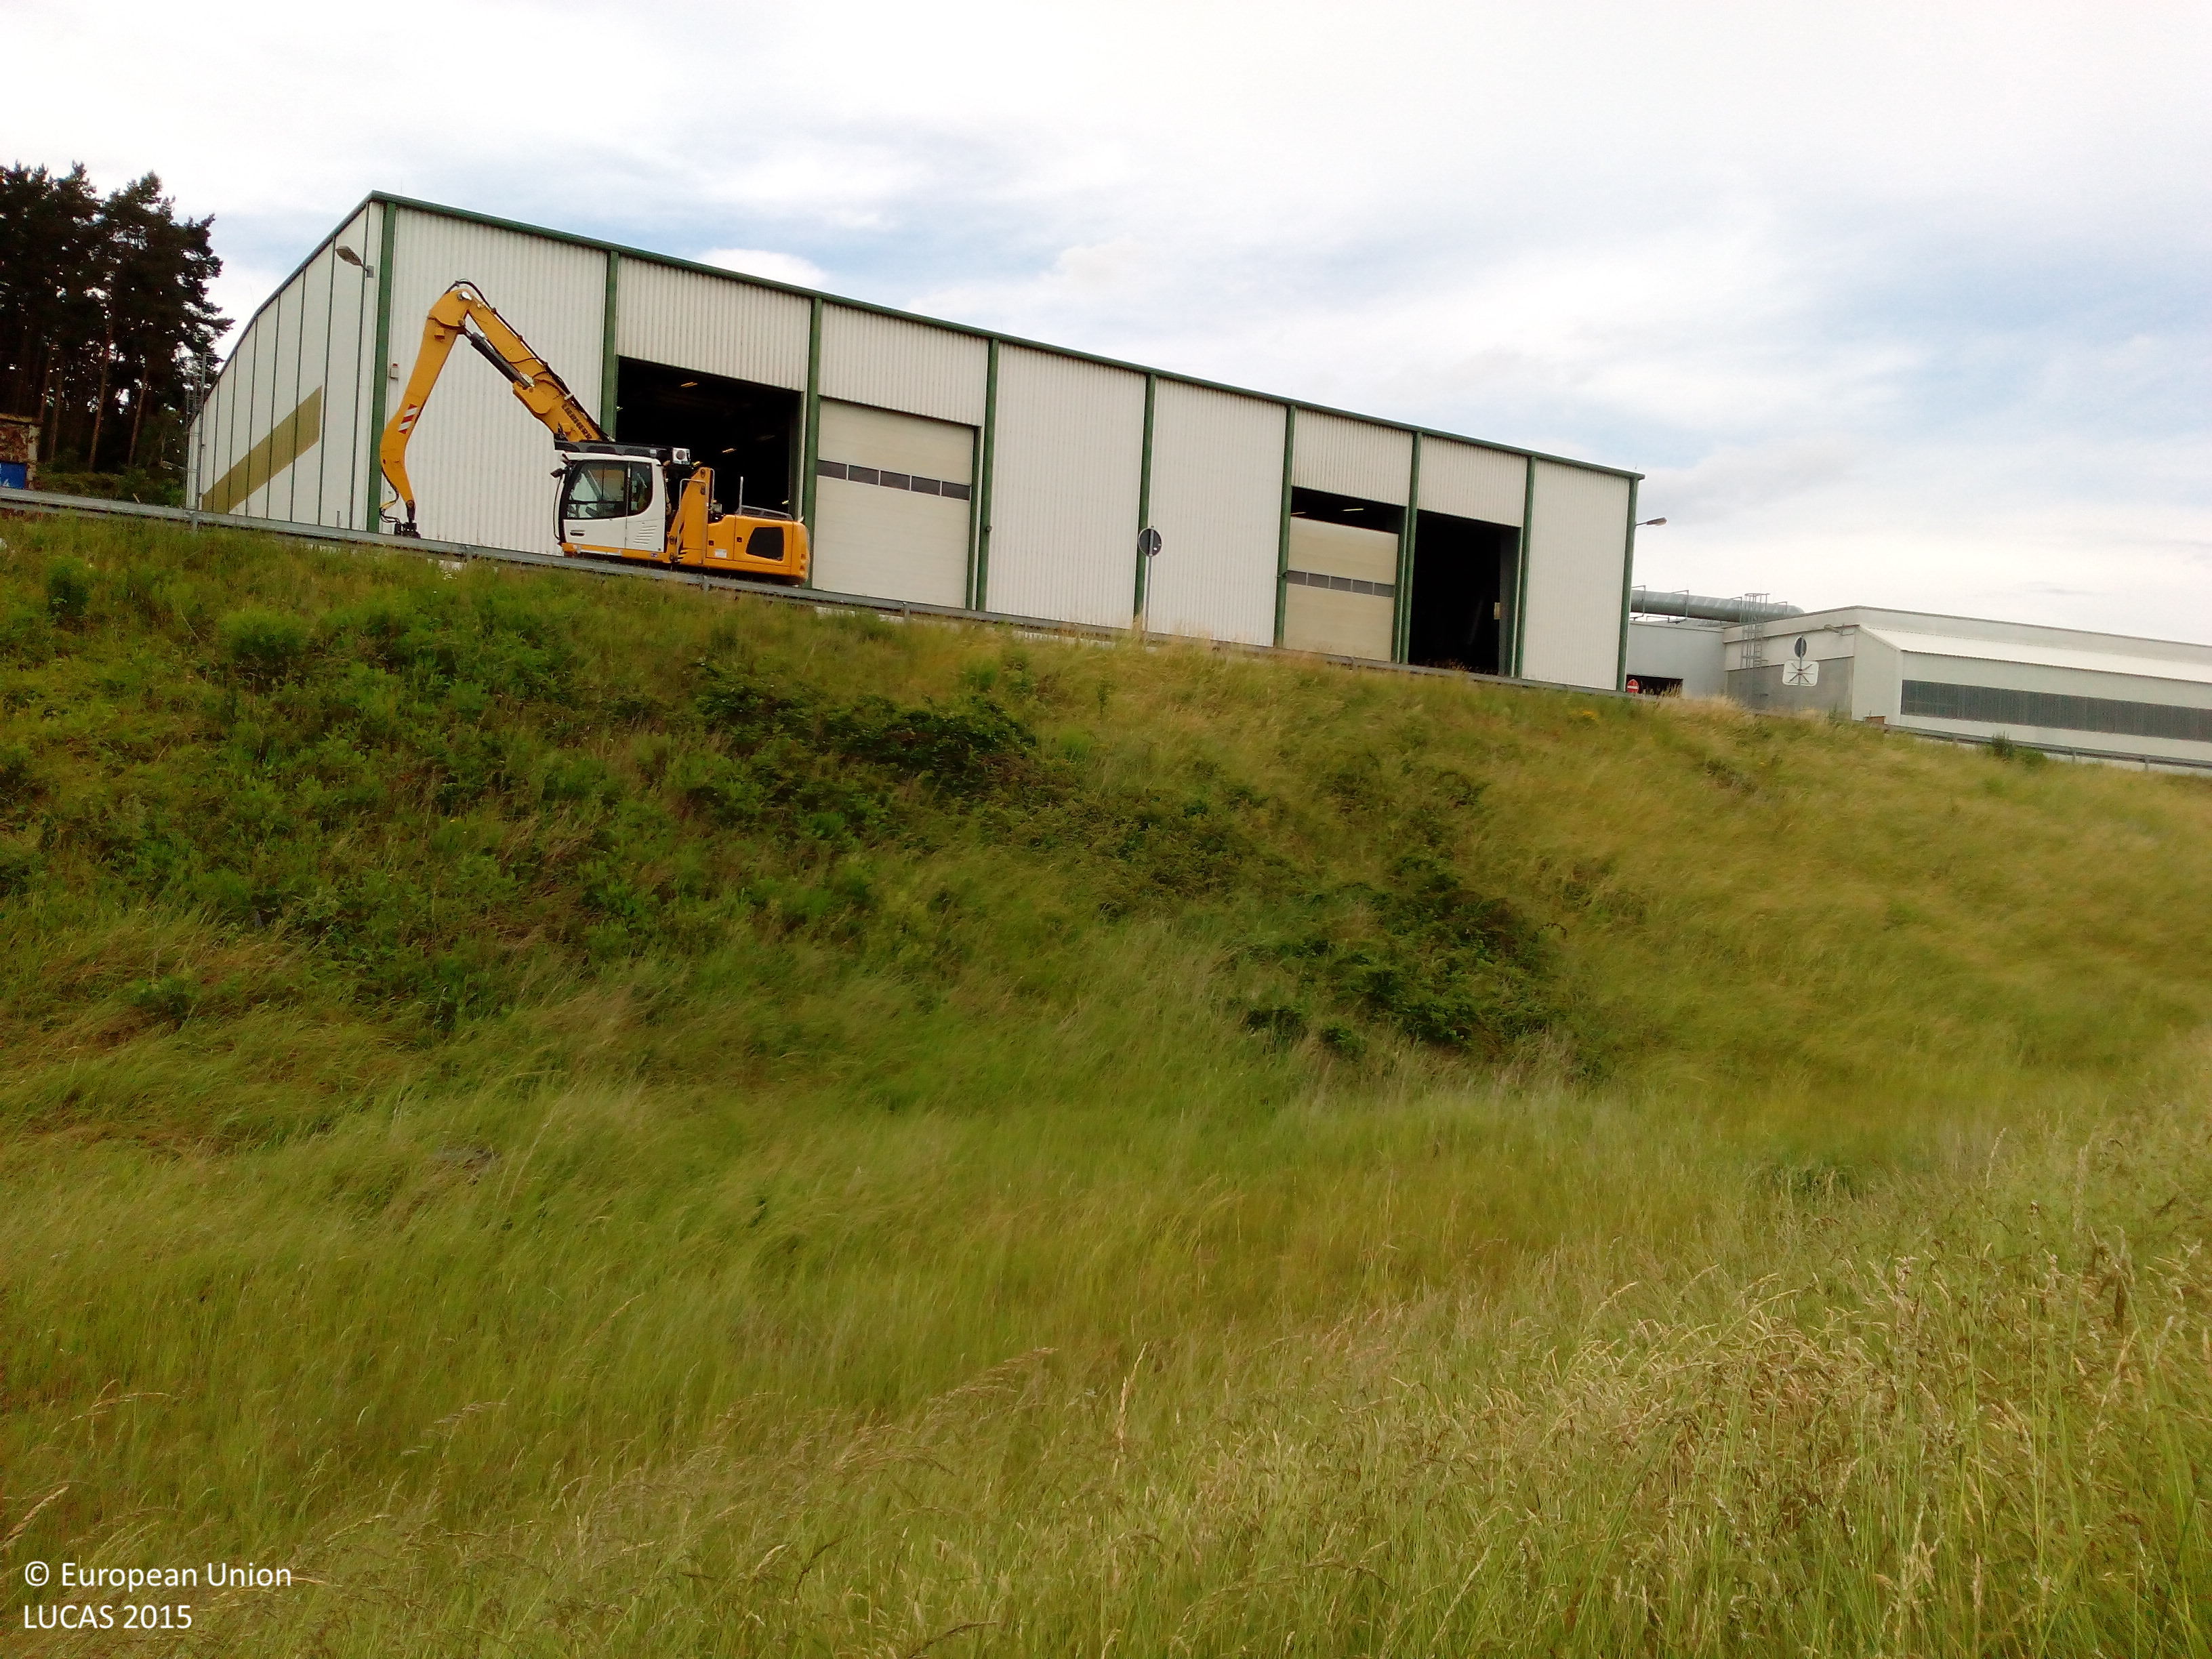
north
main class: Grassland
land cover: Grassland without tree/shrub cover
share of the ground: > 75 %
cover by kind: herbaceous plants 100 %
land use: Waste treatment
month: June
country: DE
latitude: 50.7125
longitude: 11.6000
